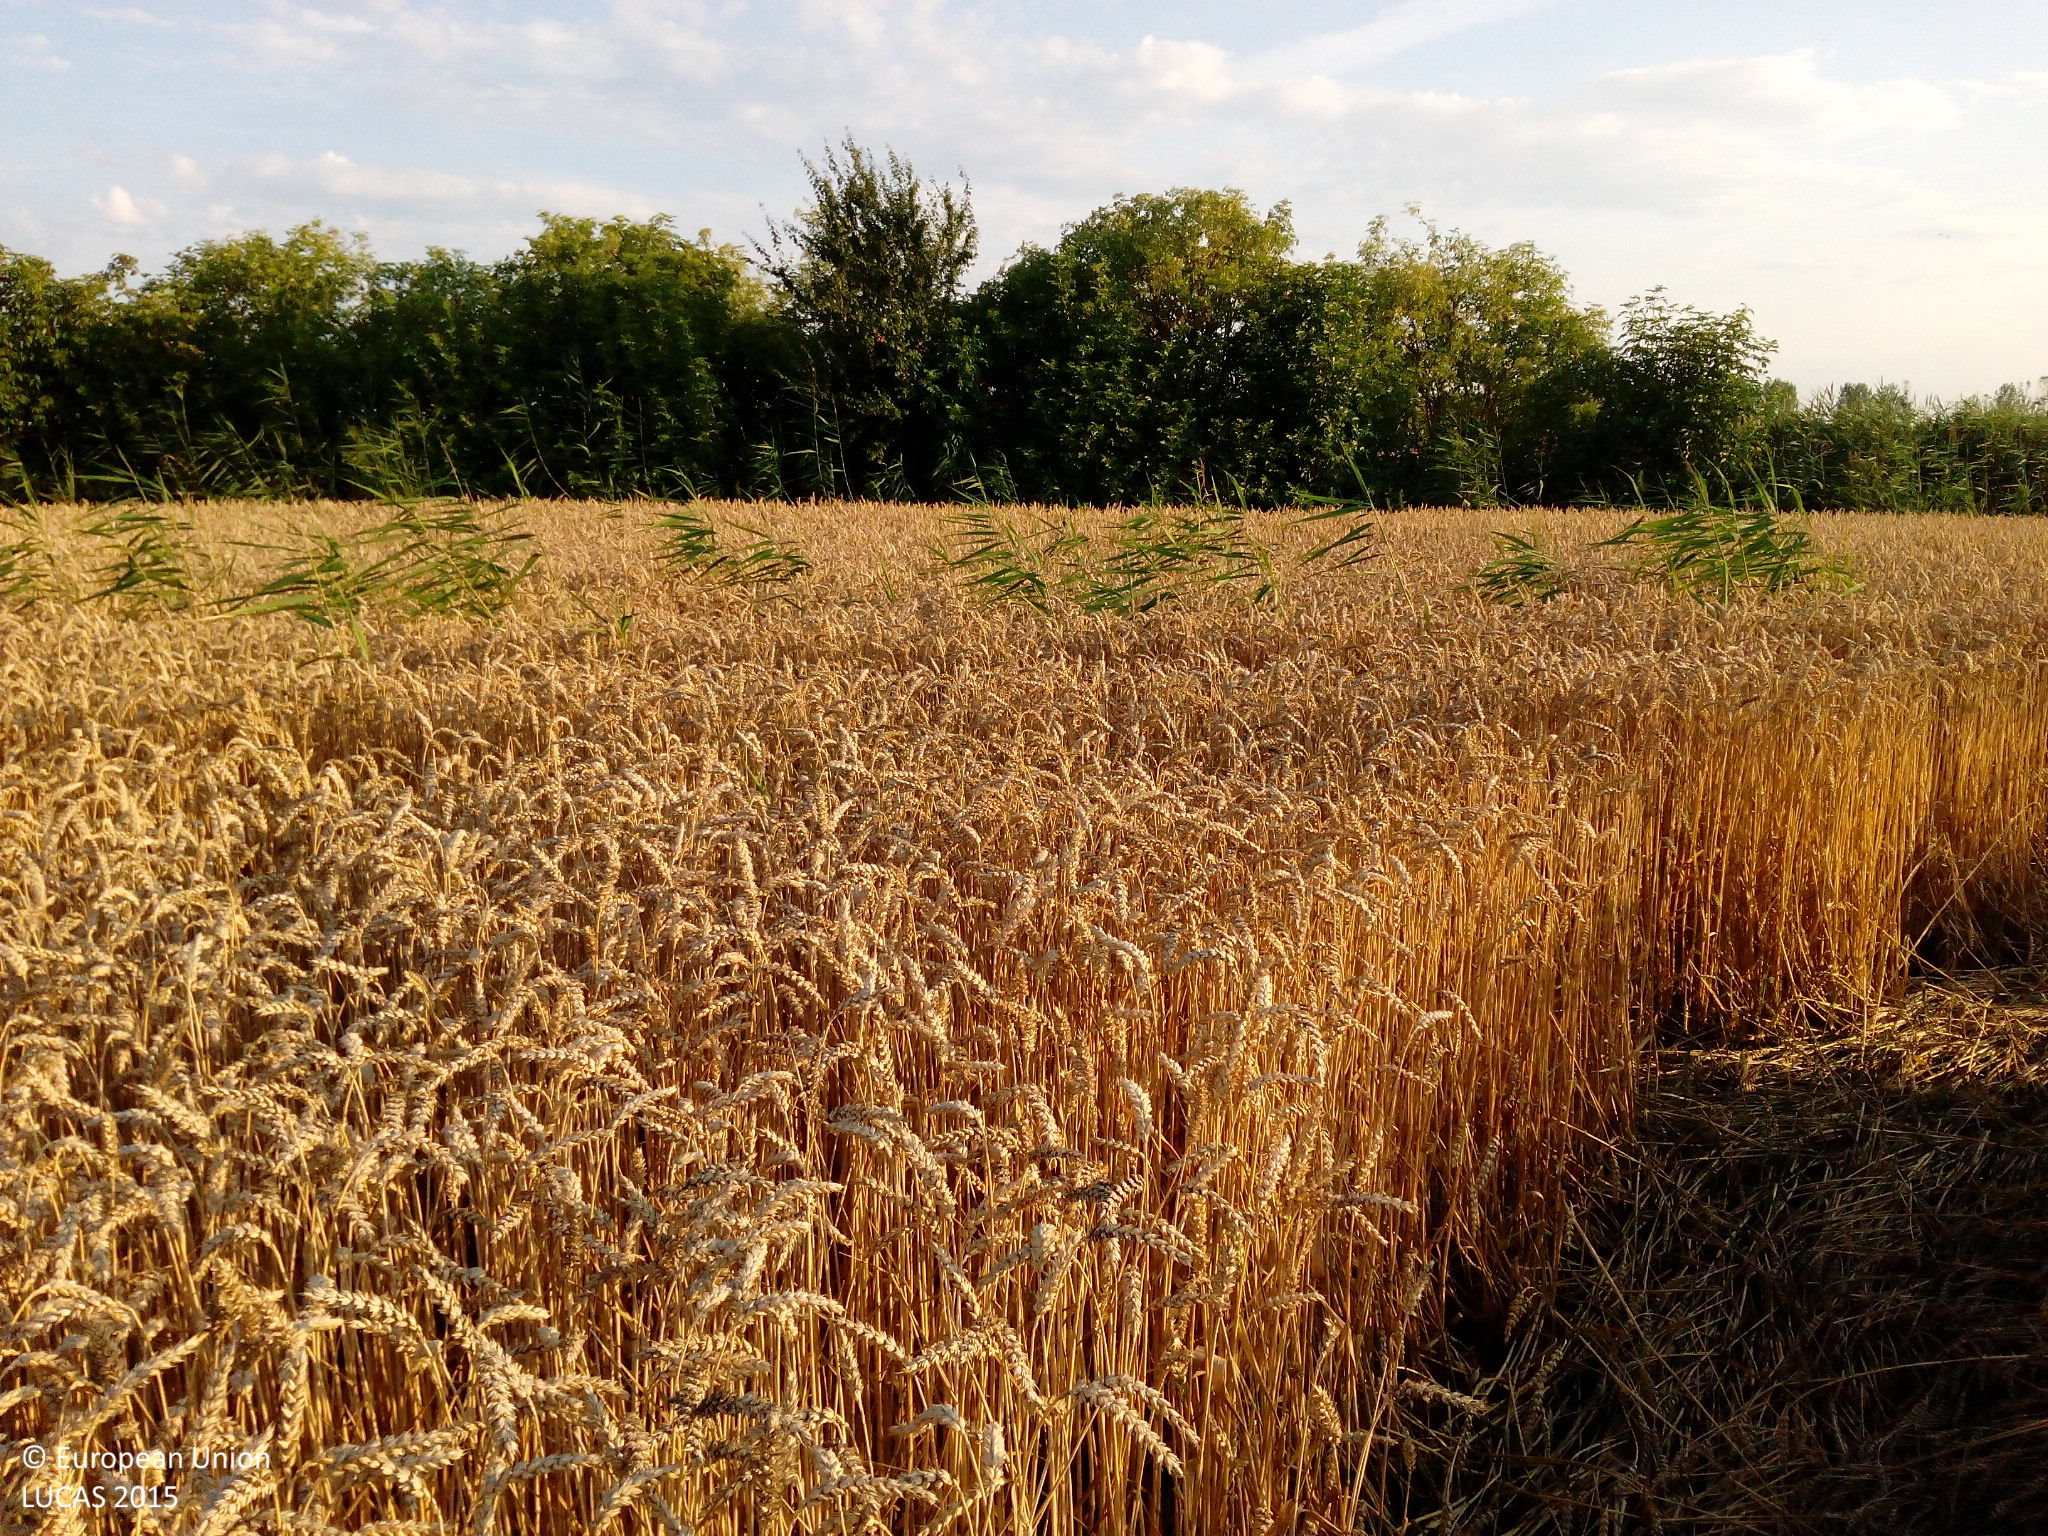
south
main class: Cropland
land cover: Common wheat
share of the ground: > 75 %
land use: Agriculture (excluding fallow land and kitchen gardens)
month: July
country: DE
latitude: 52.7524
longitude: 14.2235
